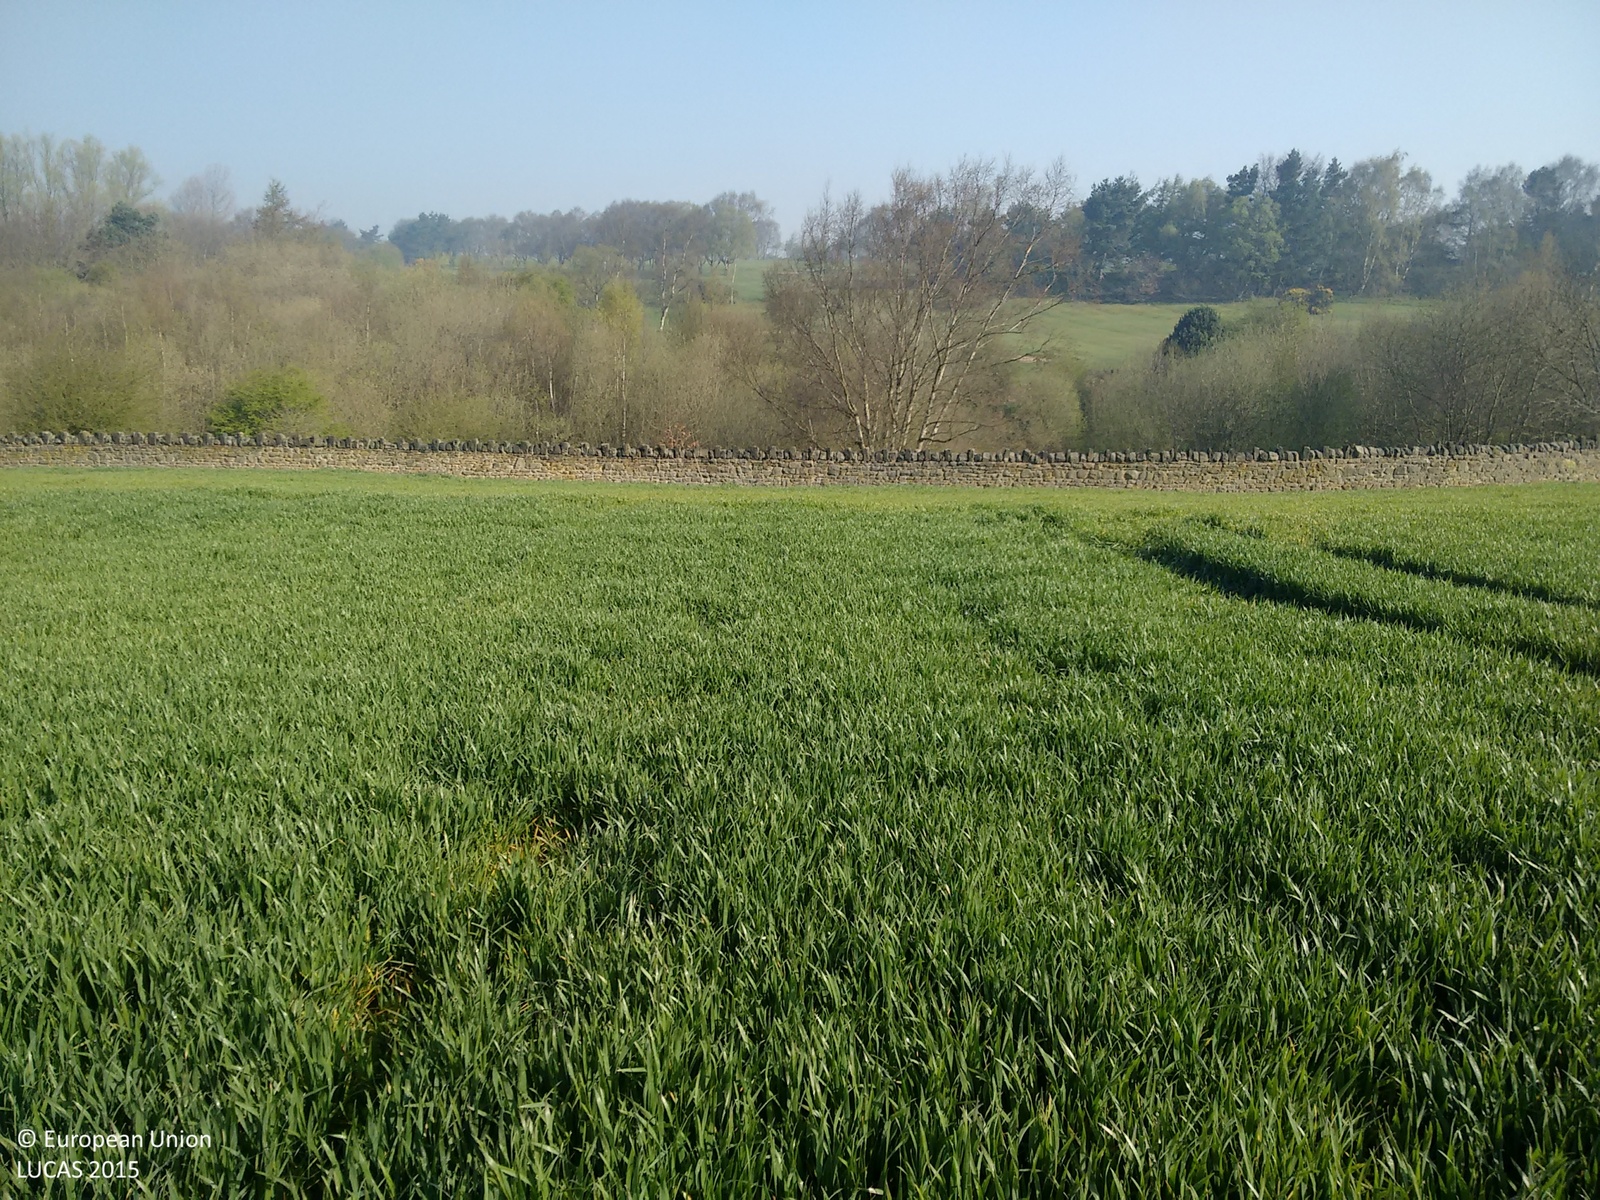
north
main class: Cropland
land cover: Common wheat
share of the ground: > 75 %
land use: Agriculture (excluding fallow land and kitchen gardens)
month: April
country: GB
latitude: 53.8550
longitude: -1.6515
